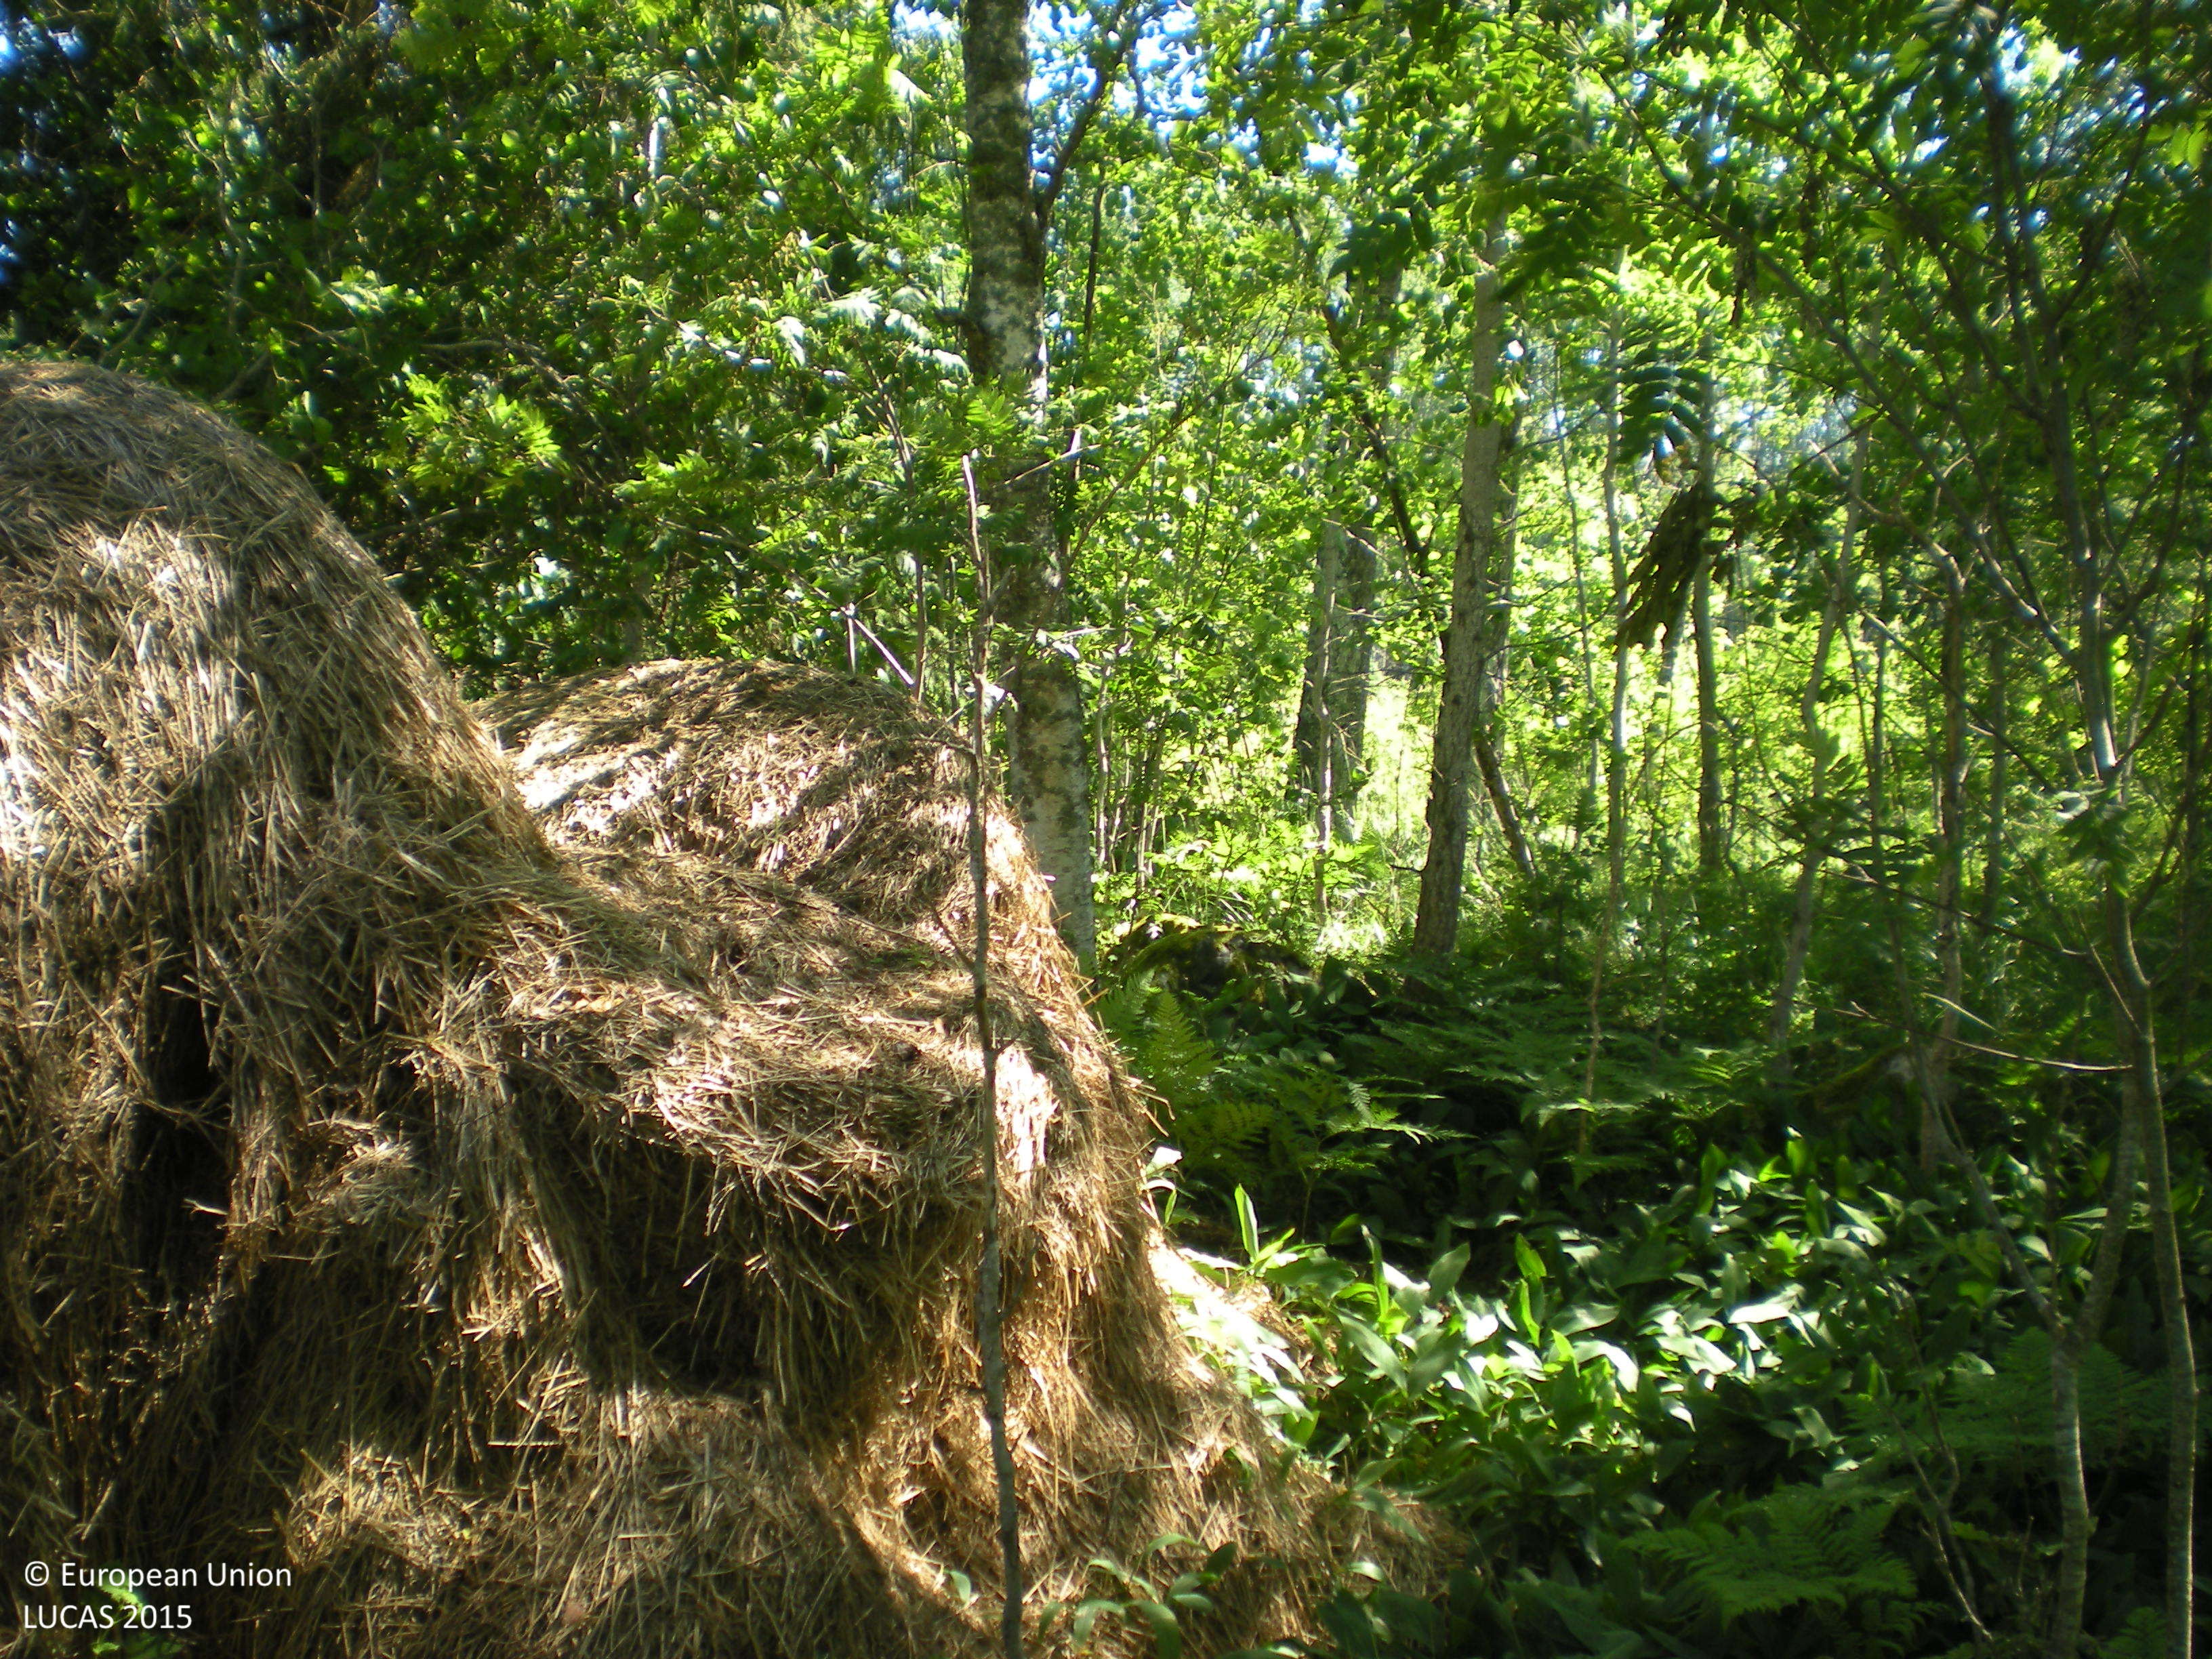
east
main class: Woodland
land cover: Broadleaved woodland
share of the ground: 50 - 75 %
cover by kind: broadleaved forest trees 45 %, herbaceous plants 40 %, shrubs 10 %, coniferous forest trees 5 %
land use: Semi-natural and natural areas not in use
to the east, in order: Broadleaved woodland; Grassland with sparse tree/shrub cover; Broadleaved woodland; Ditches and canals; Broadleaved woodland; Grassland without tree/shrub cover; Grassland with sparse tree/shrub cover; Spontaneously vegetated surfaces
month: July
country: SE
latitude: 60.4559
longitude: 17.7552
